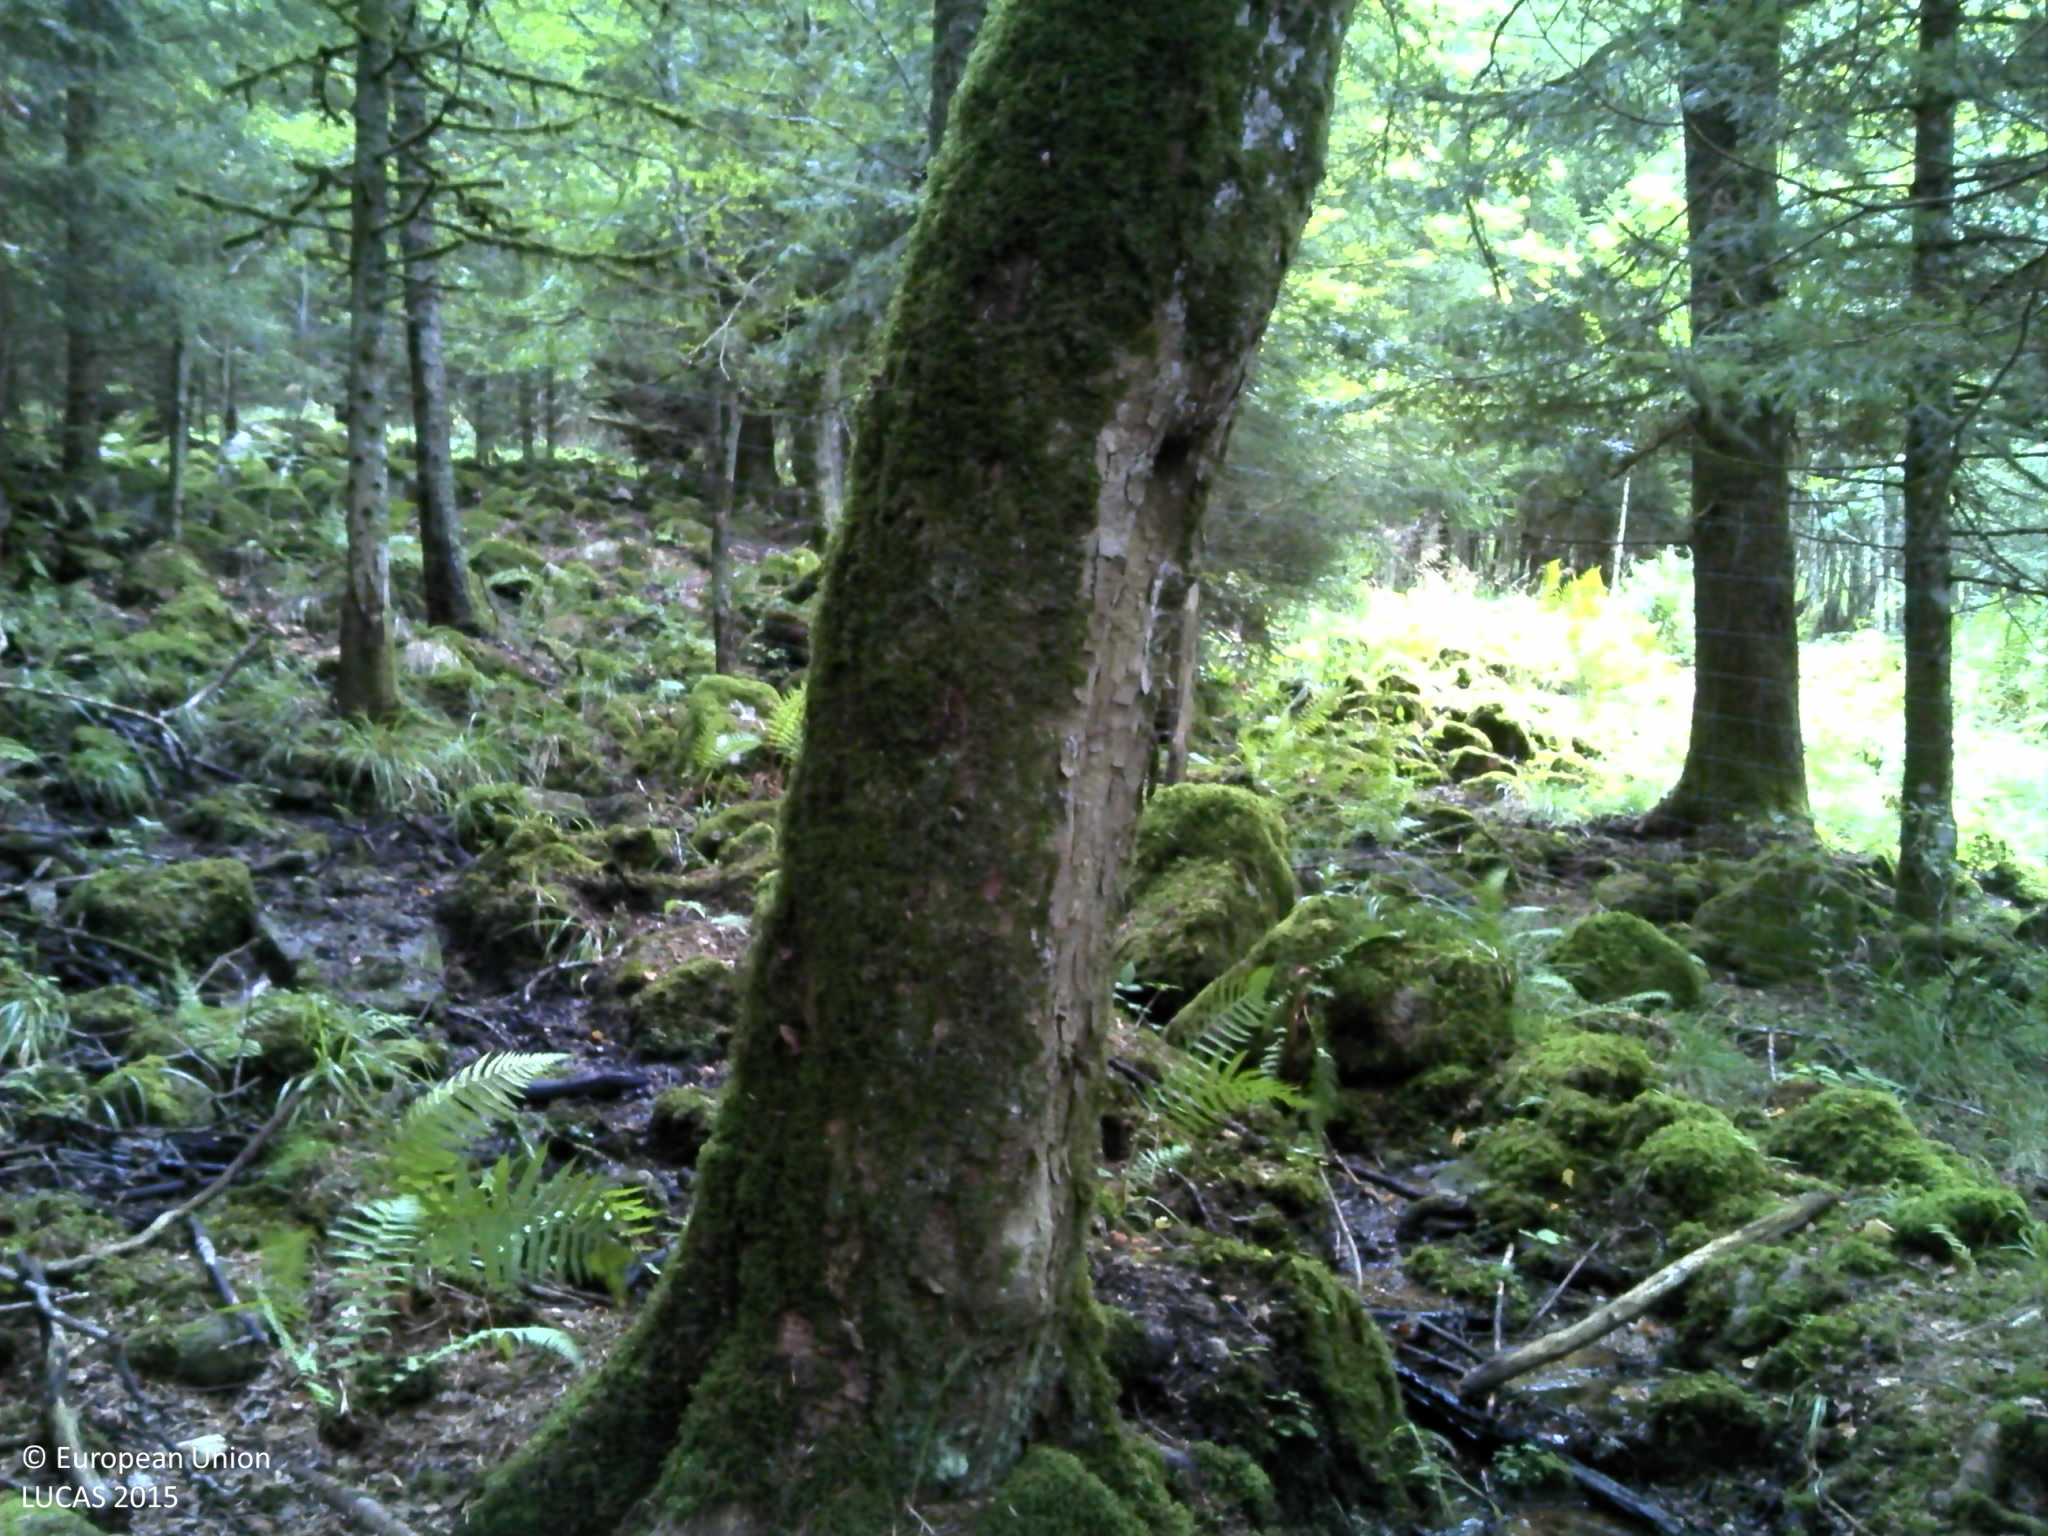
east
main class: Woodland
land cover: Spruce dominated mixed woodland
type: hemiboreal forest and nemoral coniferous forest and mixed broadleaved-coniferous forest
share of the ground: > 75 %
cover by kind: coniferous forest trees 50 %, broadleaved forest trees 30 %, consolidated bare surface 10 %, herbaceous plants 5 %, lichens and mosses 5 %
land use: Forestry
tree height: > 5 m
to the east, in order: Spruce dominated mixed woodland; Rivers and streams; Spruce dominated mixed woodland; Fences; Spruce dominated mixed woodland; Fences; Spruce dominated mixed woodland; Tracks; Spruce dominated mixed woodland; Tracks; Spruce dominated coniferous woodland
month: September
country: FR
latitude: 48.4242
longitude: 7.2846
